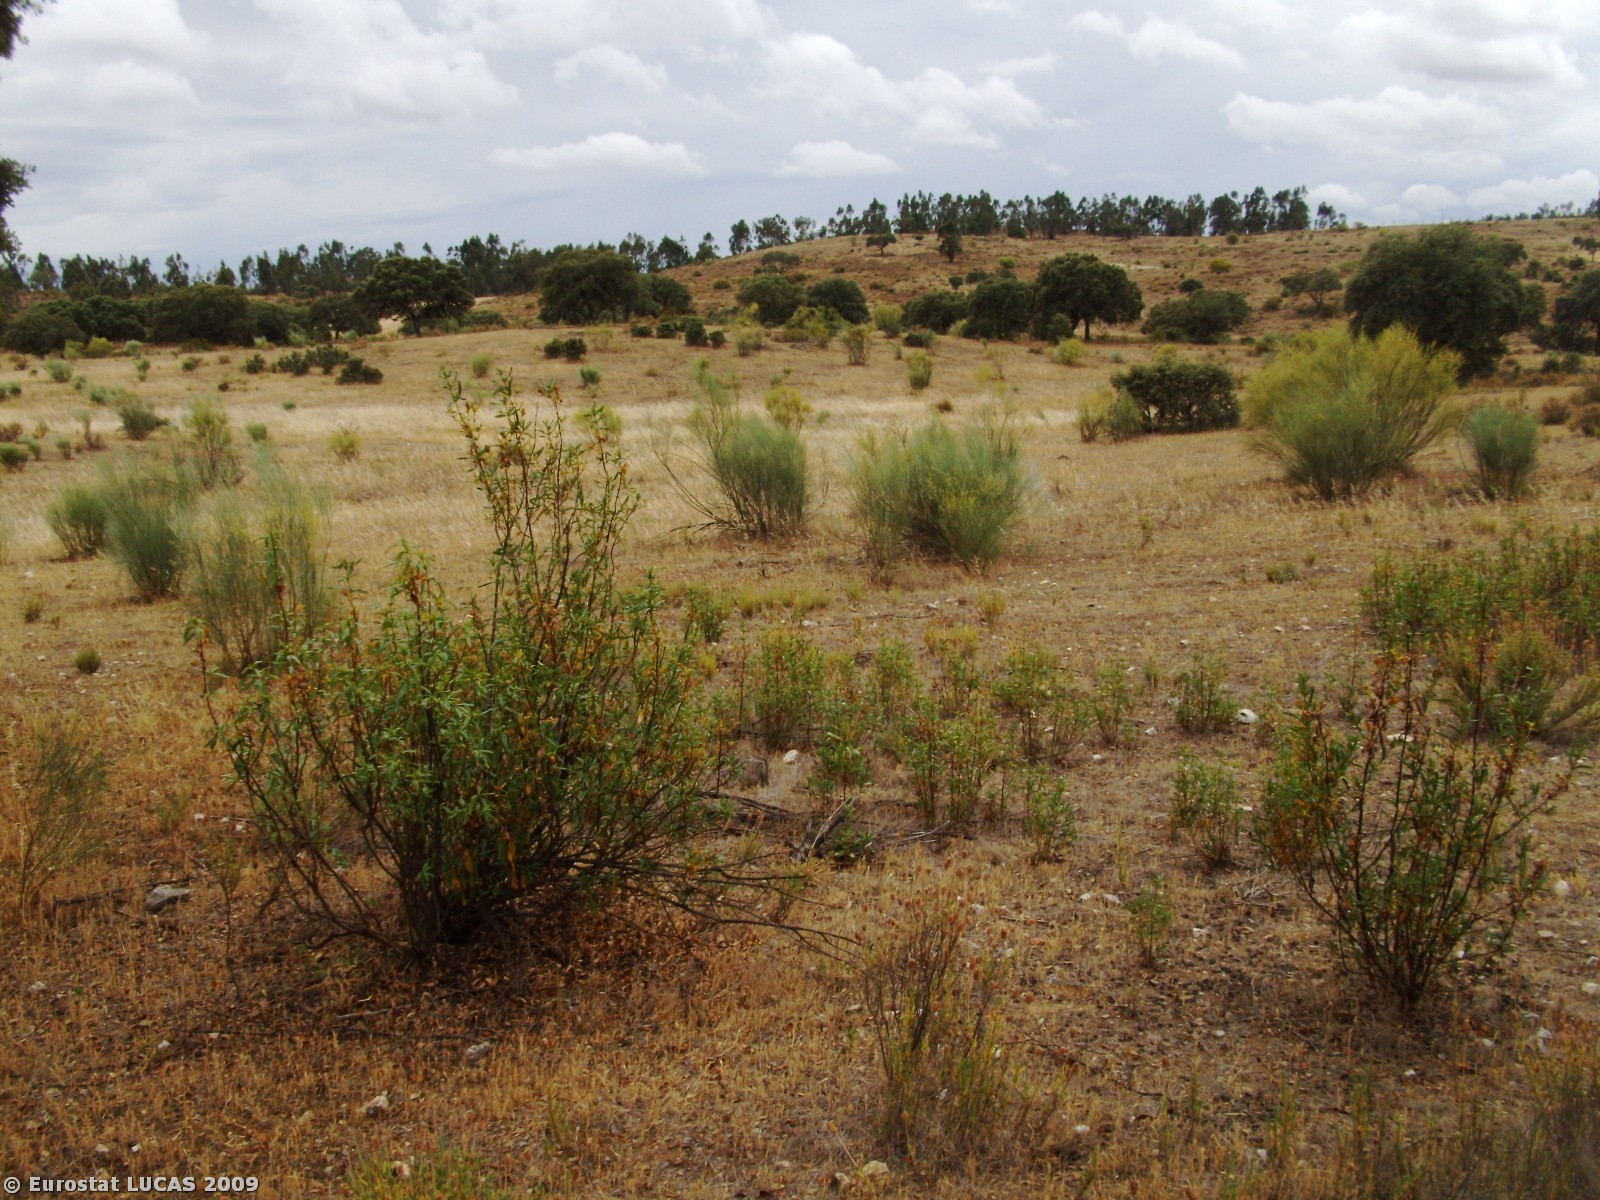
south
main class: Woodland
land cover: Broadleaved woodland
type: broadleaved evergreen forest
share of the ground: 25 - 50 %
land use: Forestry
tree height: > 5 m
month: June
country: PT
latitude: 39.7020
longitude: -7.0559
